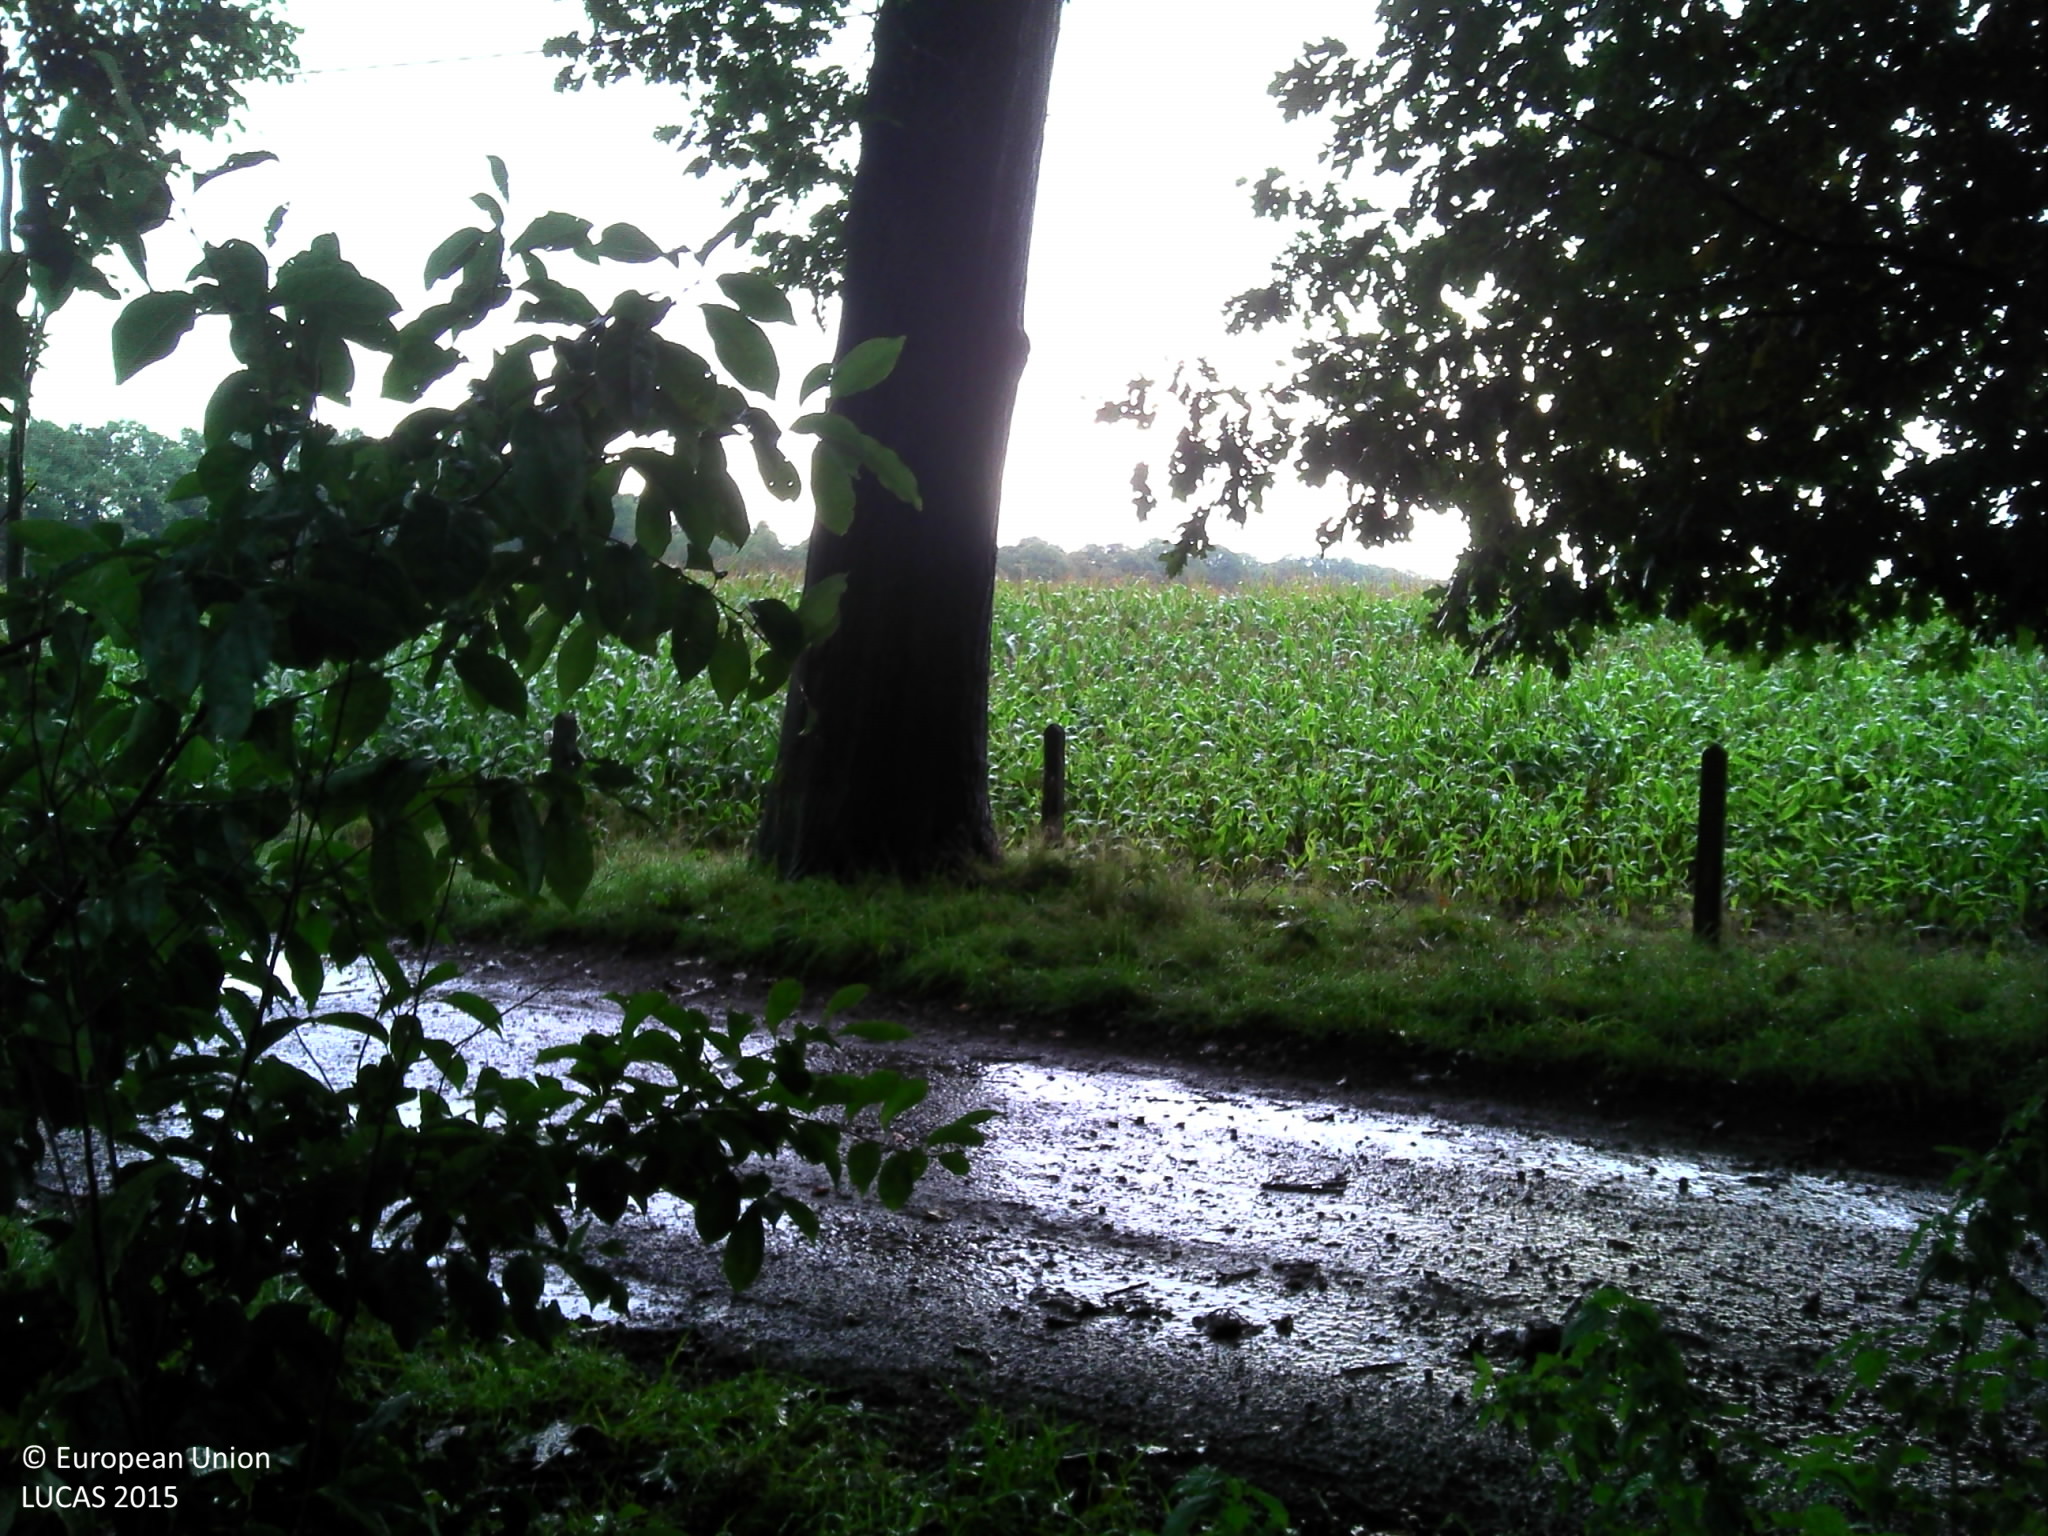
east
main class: Grassland
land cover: Grassland without tree/shrub cover
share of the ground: > 75 %
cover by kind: herbaceous plants 95 %, unconsolidated bare surface 5 %
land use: Agriculture (excluding fallow land and kitchen gardens)
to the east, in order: Grassland without tree/shrub cover; Electric lines; Grassland without tree/shrub cover; Fences; Grass margins; Tracks; Grass margins; Fences; Other fibre and oleaginous crops; Fences; Lines of trees; Grass margins; Tracks; Lines of trees; Grass margins; Fences; Maize
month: September
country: BE
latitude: 51.2839
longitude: 4.6482
